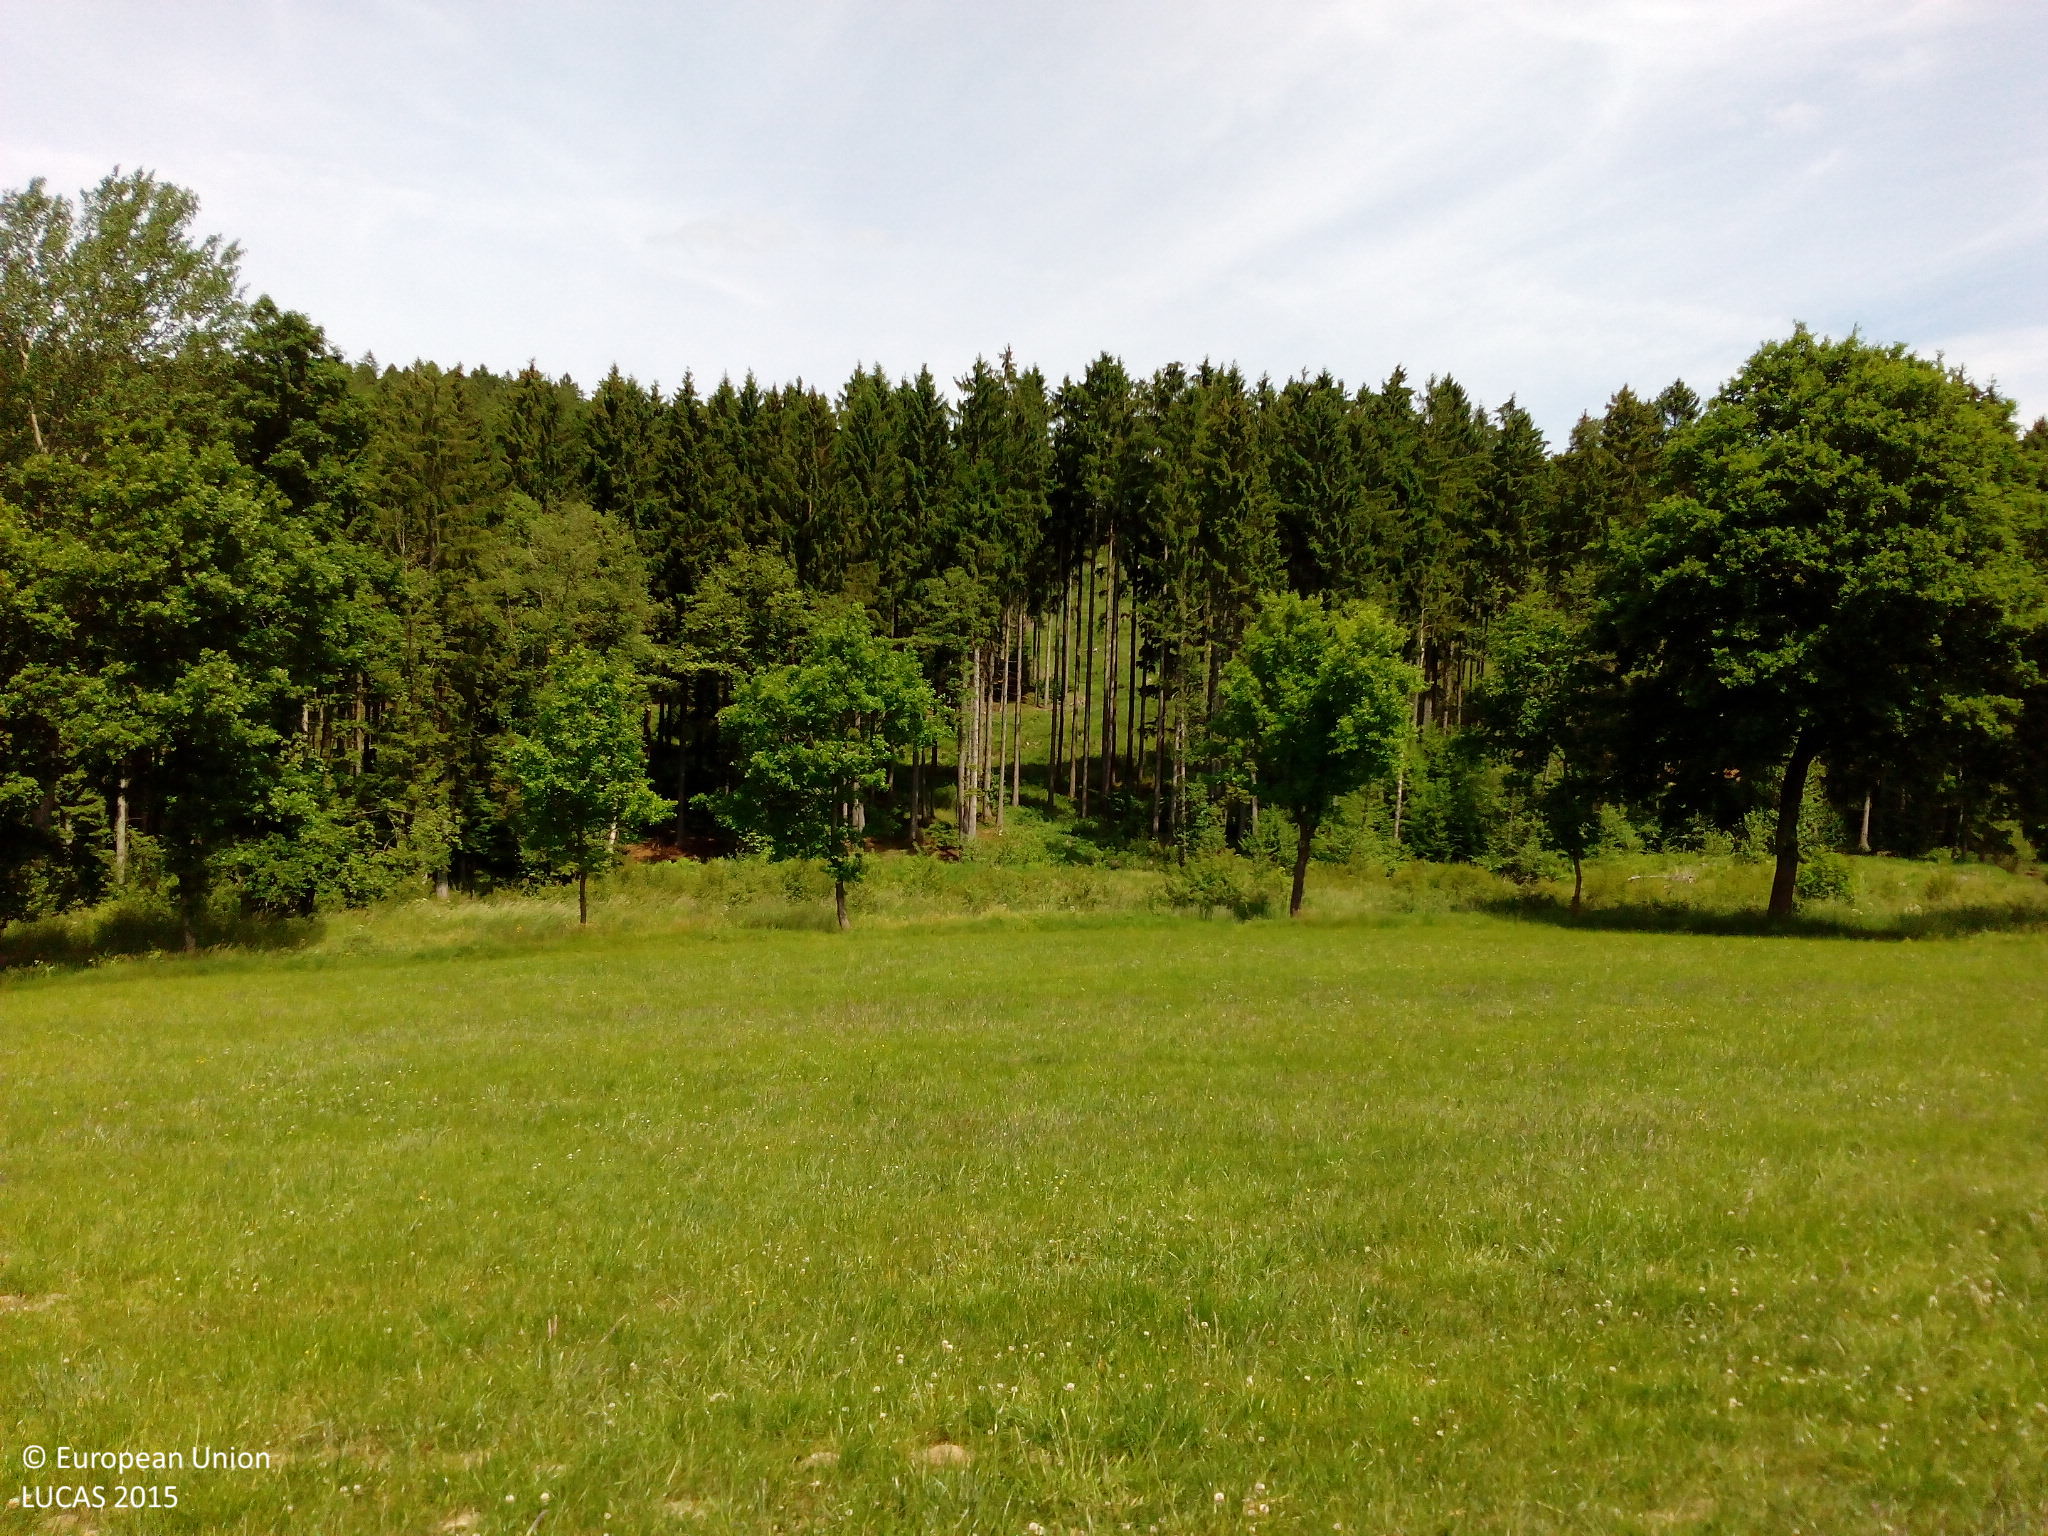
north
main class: Grassland
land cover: Grassland without tree/shrub cover
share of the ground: > 75 %
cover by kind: herbaceous plants 100 %
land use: Agriculture (excluding fallow land and kitchen gardens)
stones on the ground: < 10 %
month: June
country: DE
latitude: 51.4506
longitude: 8.4606
